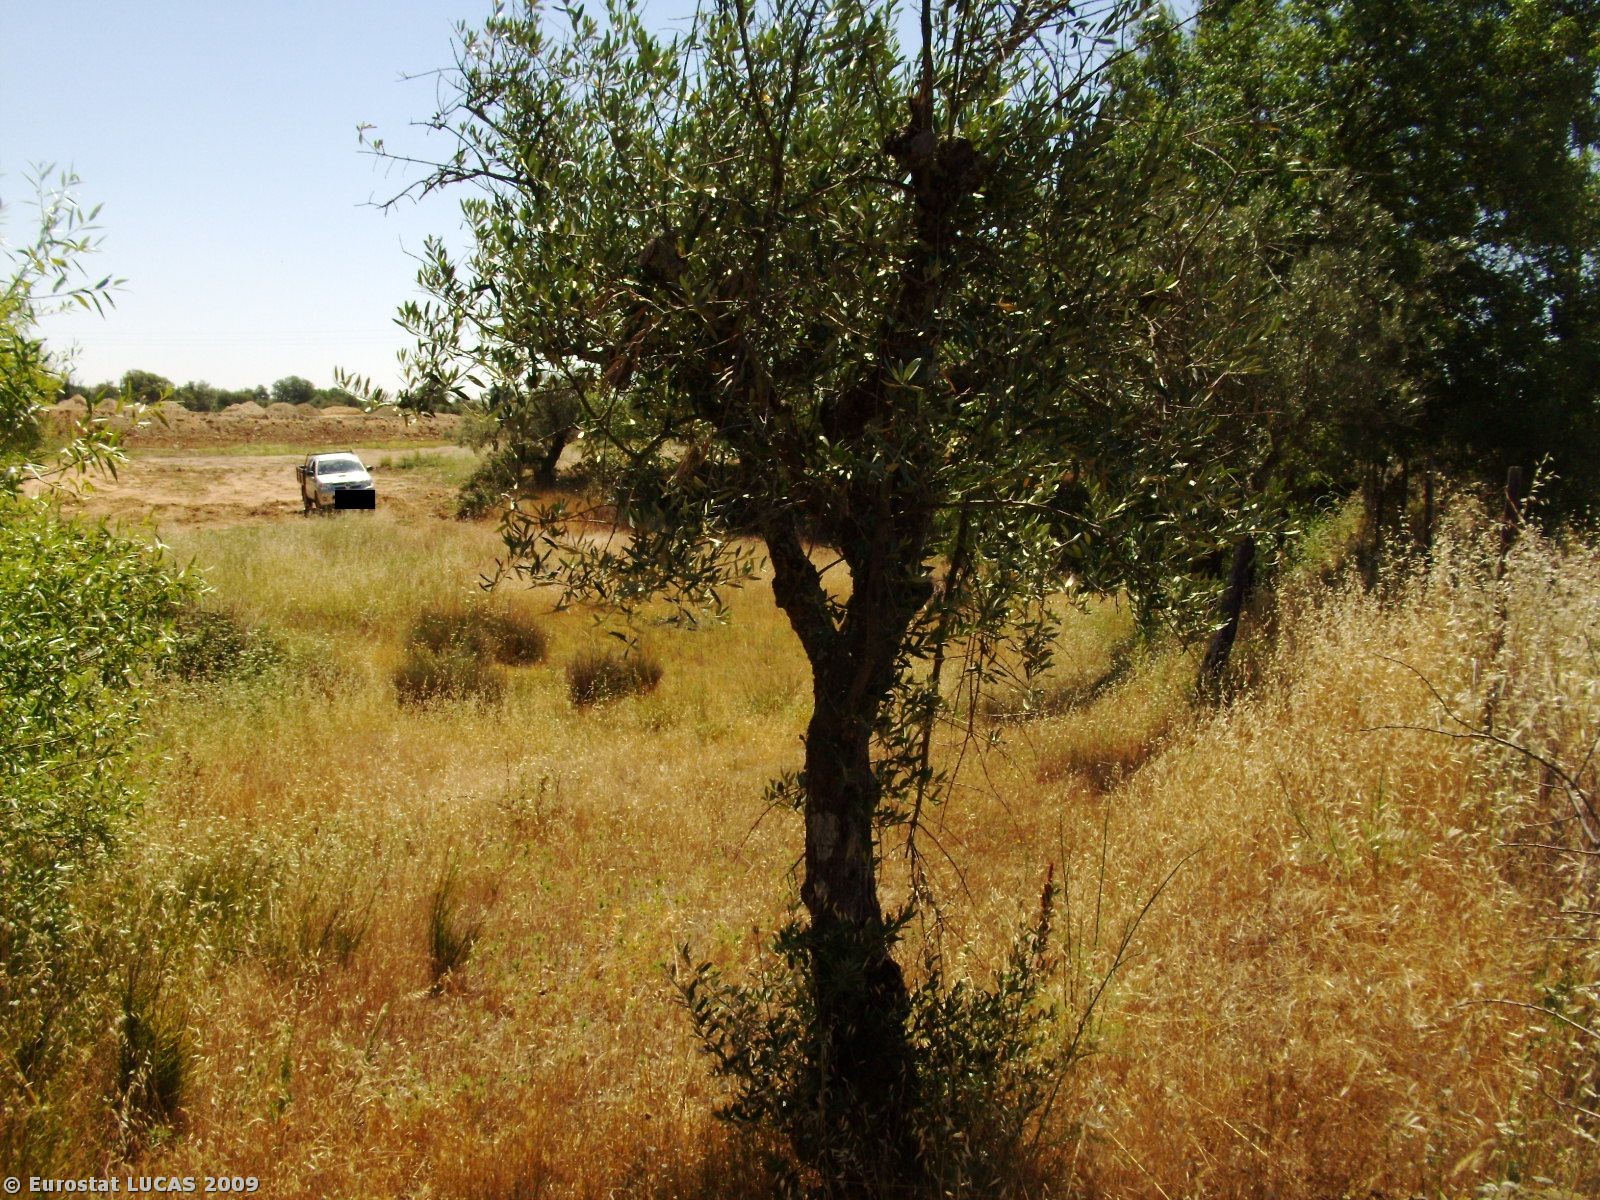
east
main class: Grassland
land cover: Spontaneously vegetated surfaces
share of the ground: > 75 %
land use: Fallow land
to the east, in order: Spontaneously vegetated surfaces; Fences; Spontaneously vegetated surfaces; Rivers and streams; Olive groves; Paved roads, cycling and walking lanes; Olive groves; Rivers and streams
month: June
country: PT
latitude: 39.8319
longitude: -7.2583
